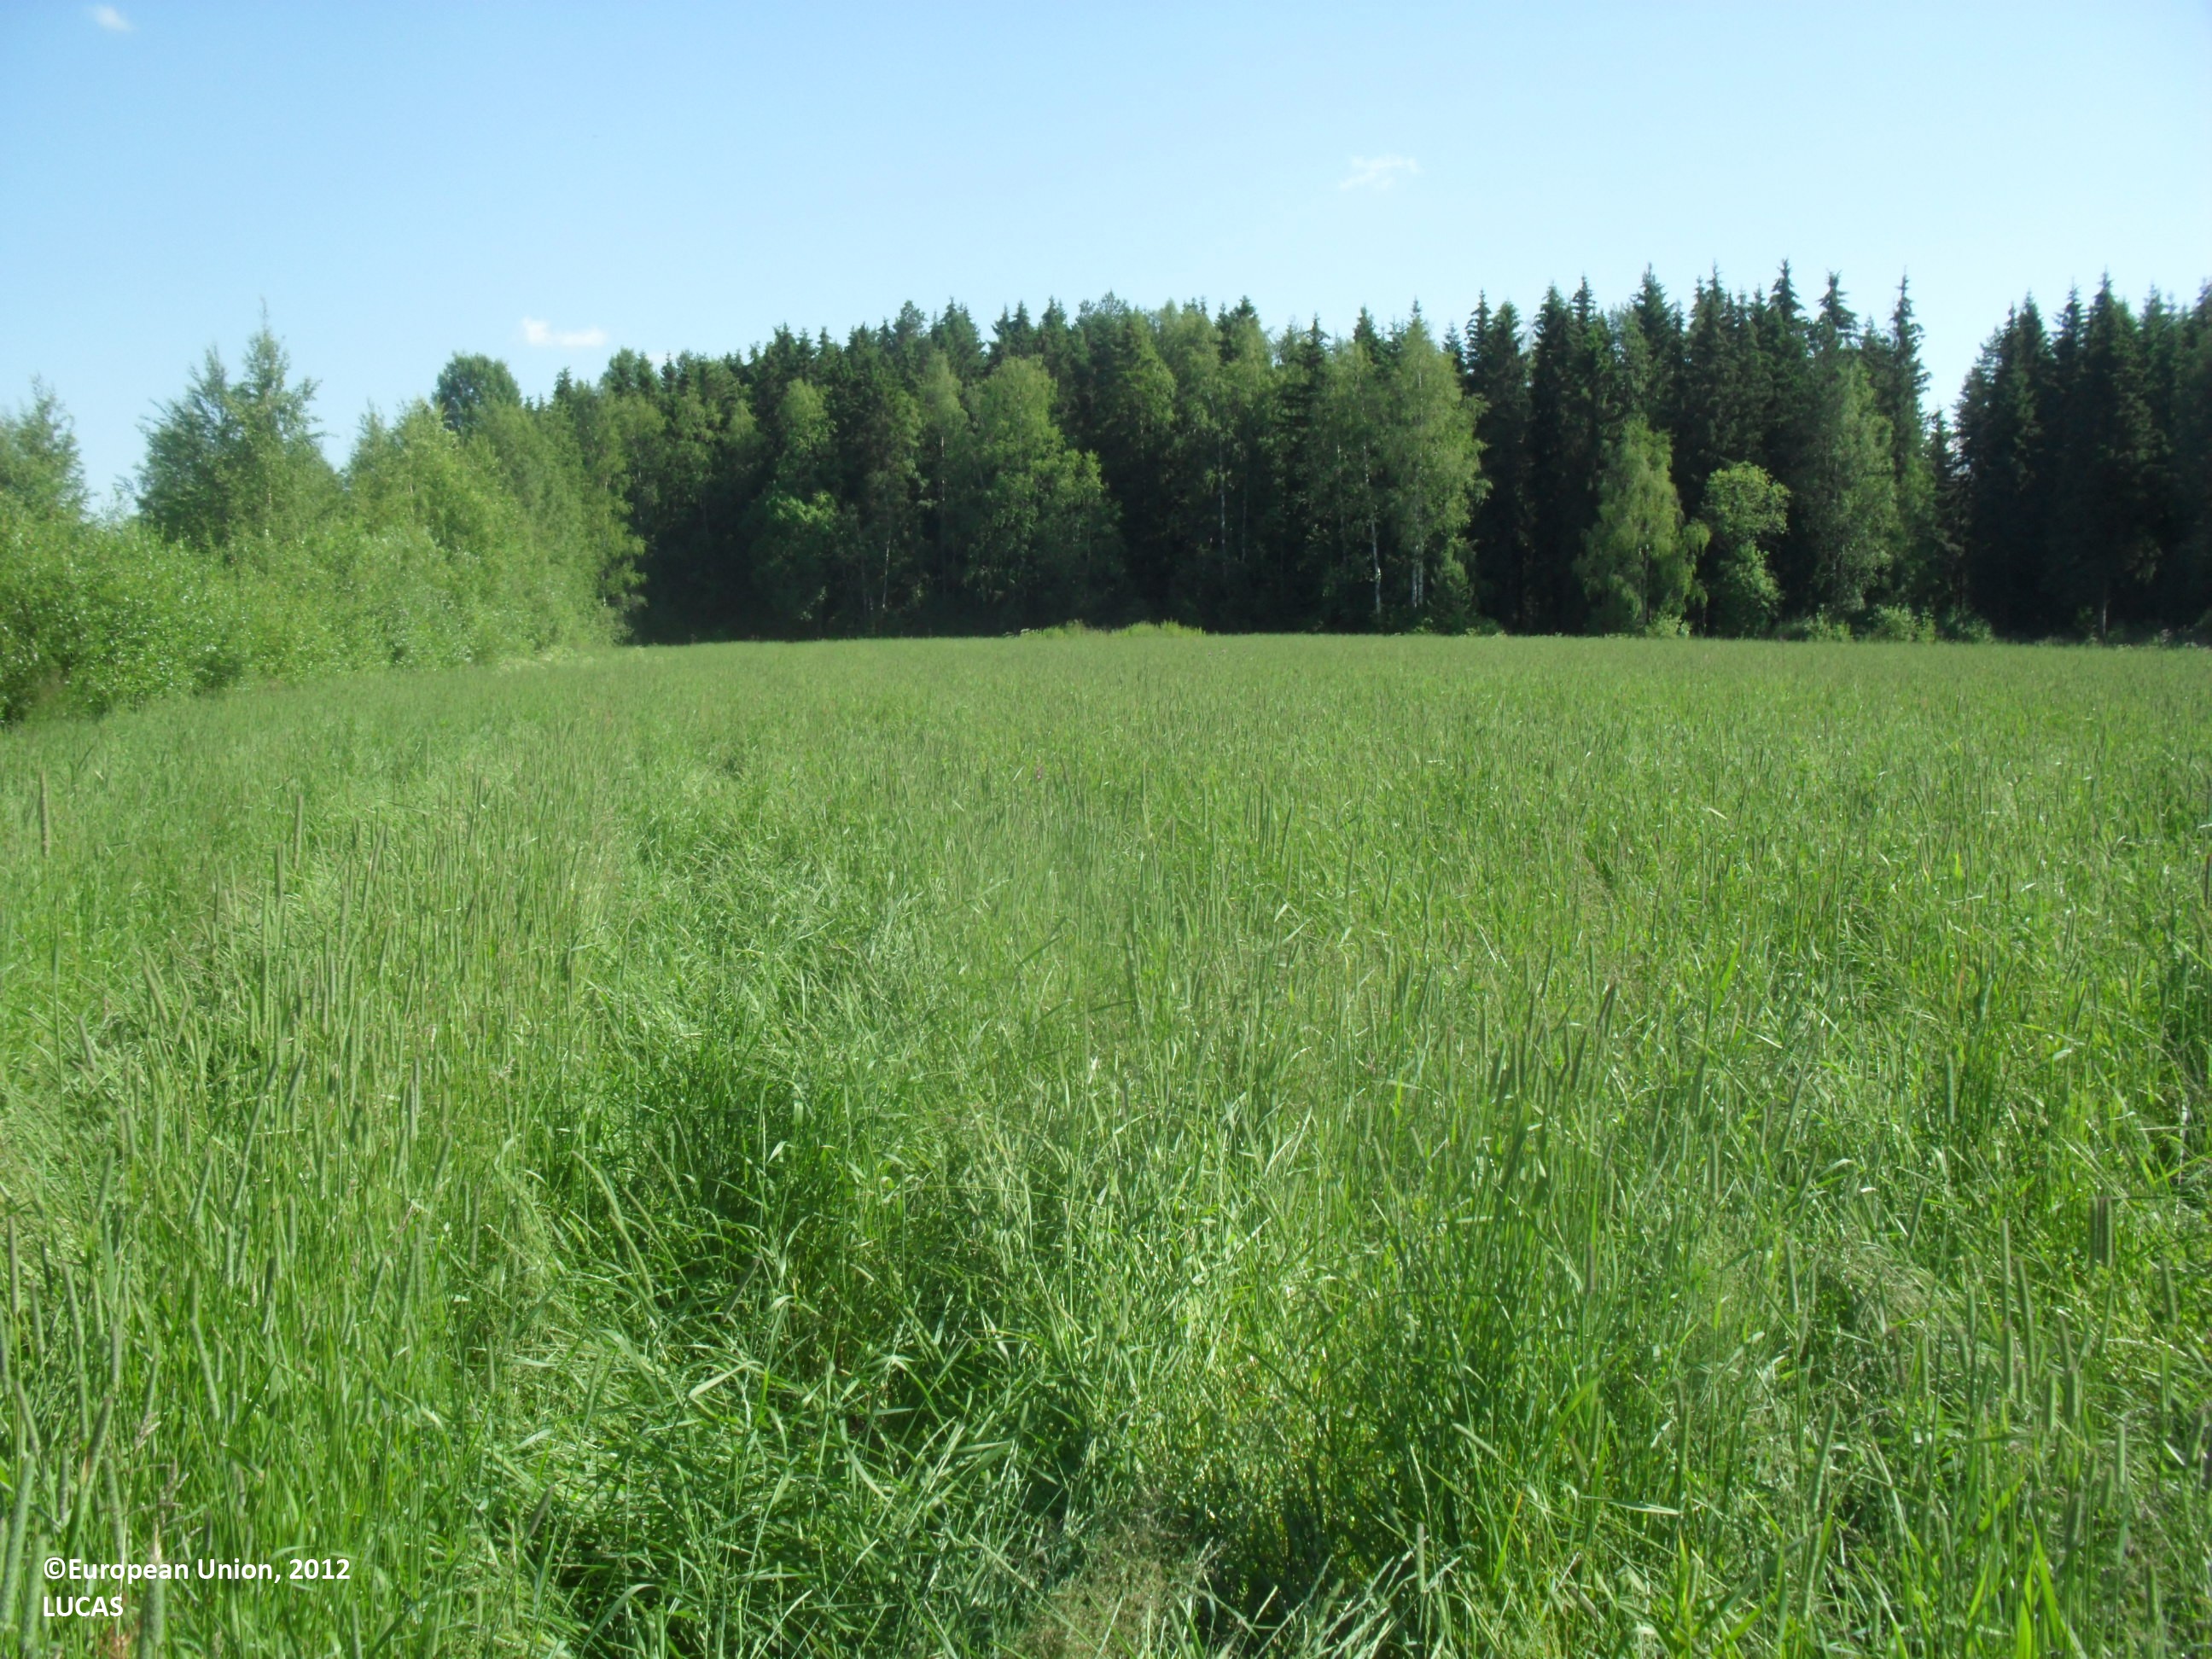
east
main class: Cropland
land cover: Temporary grasslands
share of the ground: > 75 %
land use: Agriculture (excluding fallow land and kitchen gardens)
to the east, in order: Temporary grasslands; Ditches and canals; Barley; Grass margins; Ditches and canals; Barley; Abandoned hedges; Spruce dominated coniferous woodland; Rivers and streams; Other mixed woodland
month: July
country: FI
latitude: 63.1814
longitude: 23.8386
